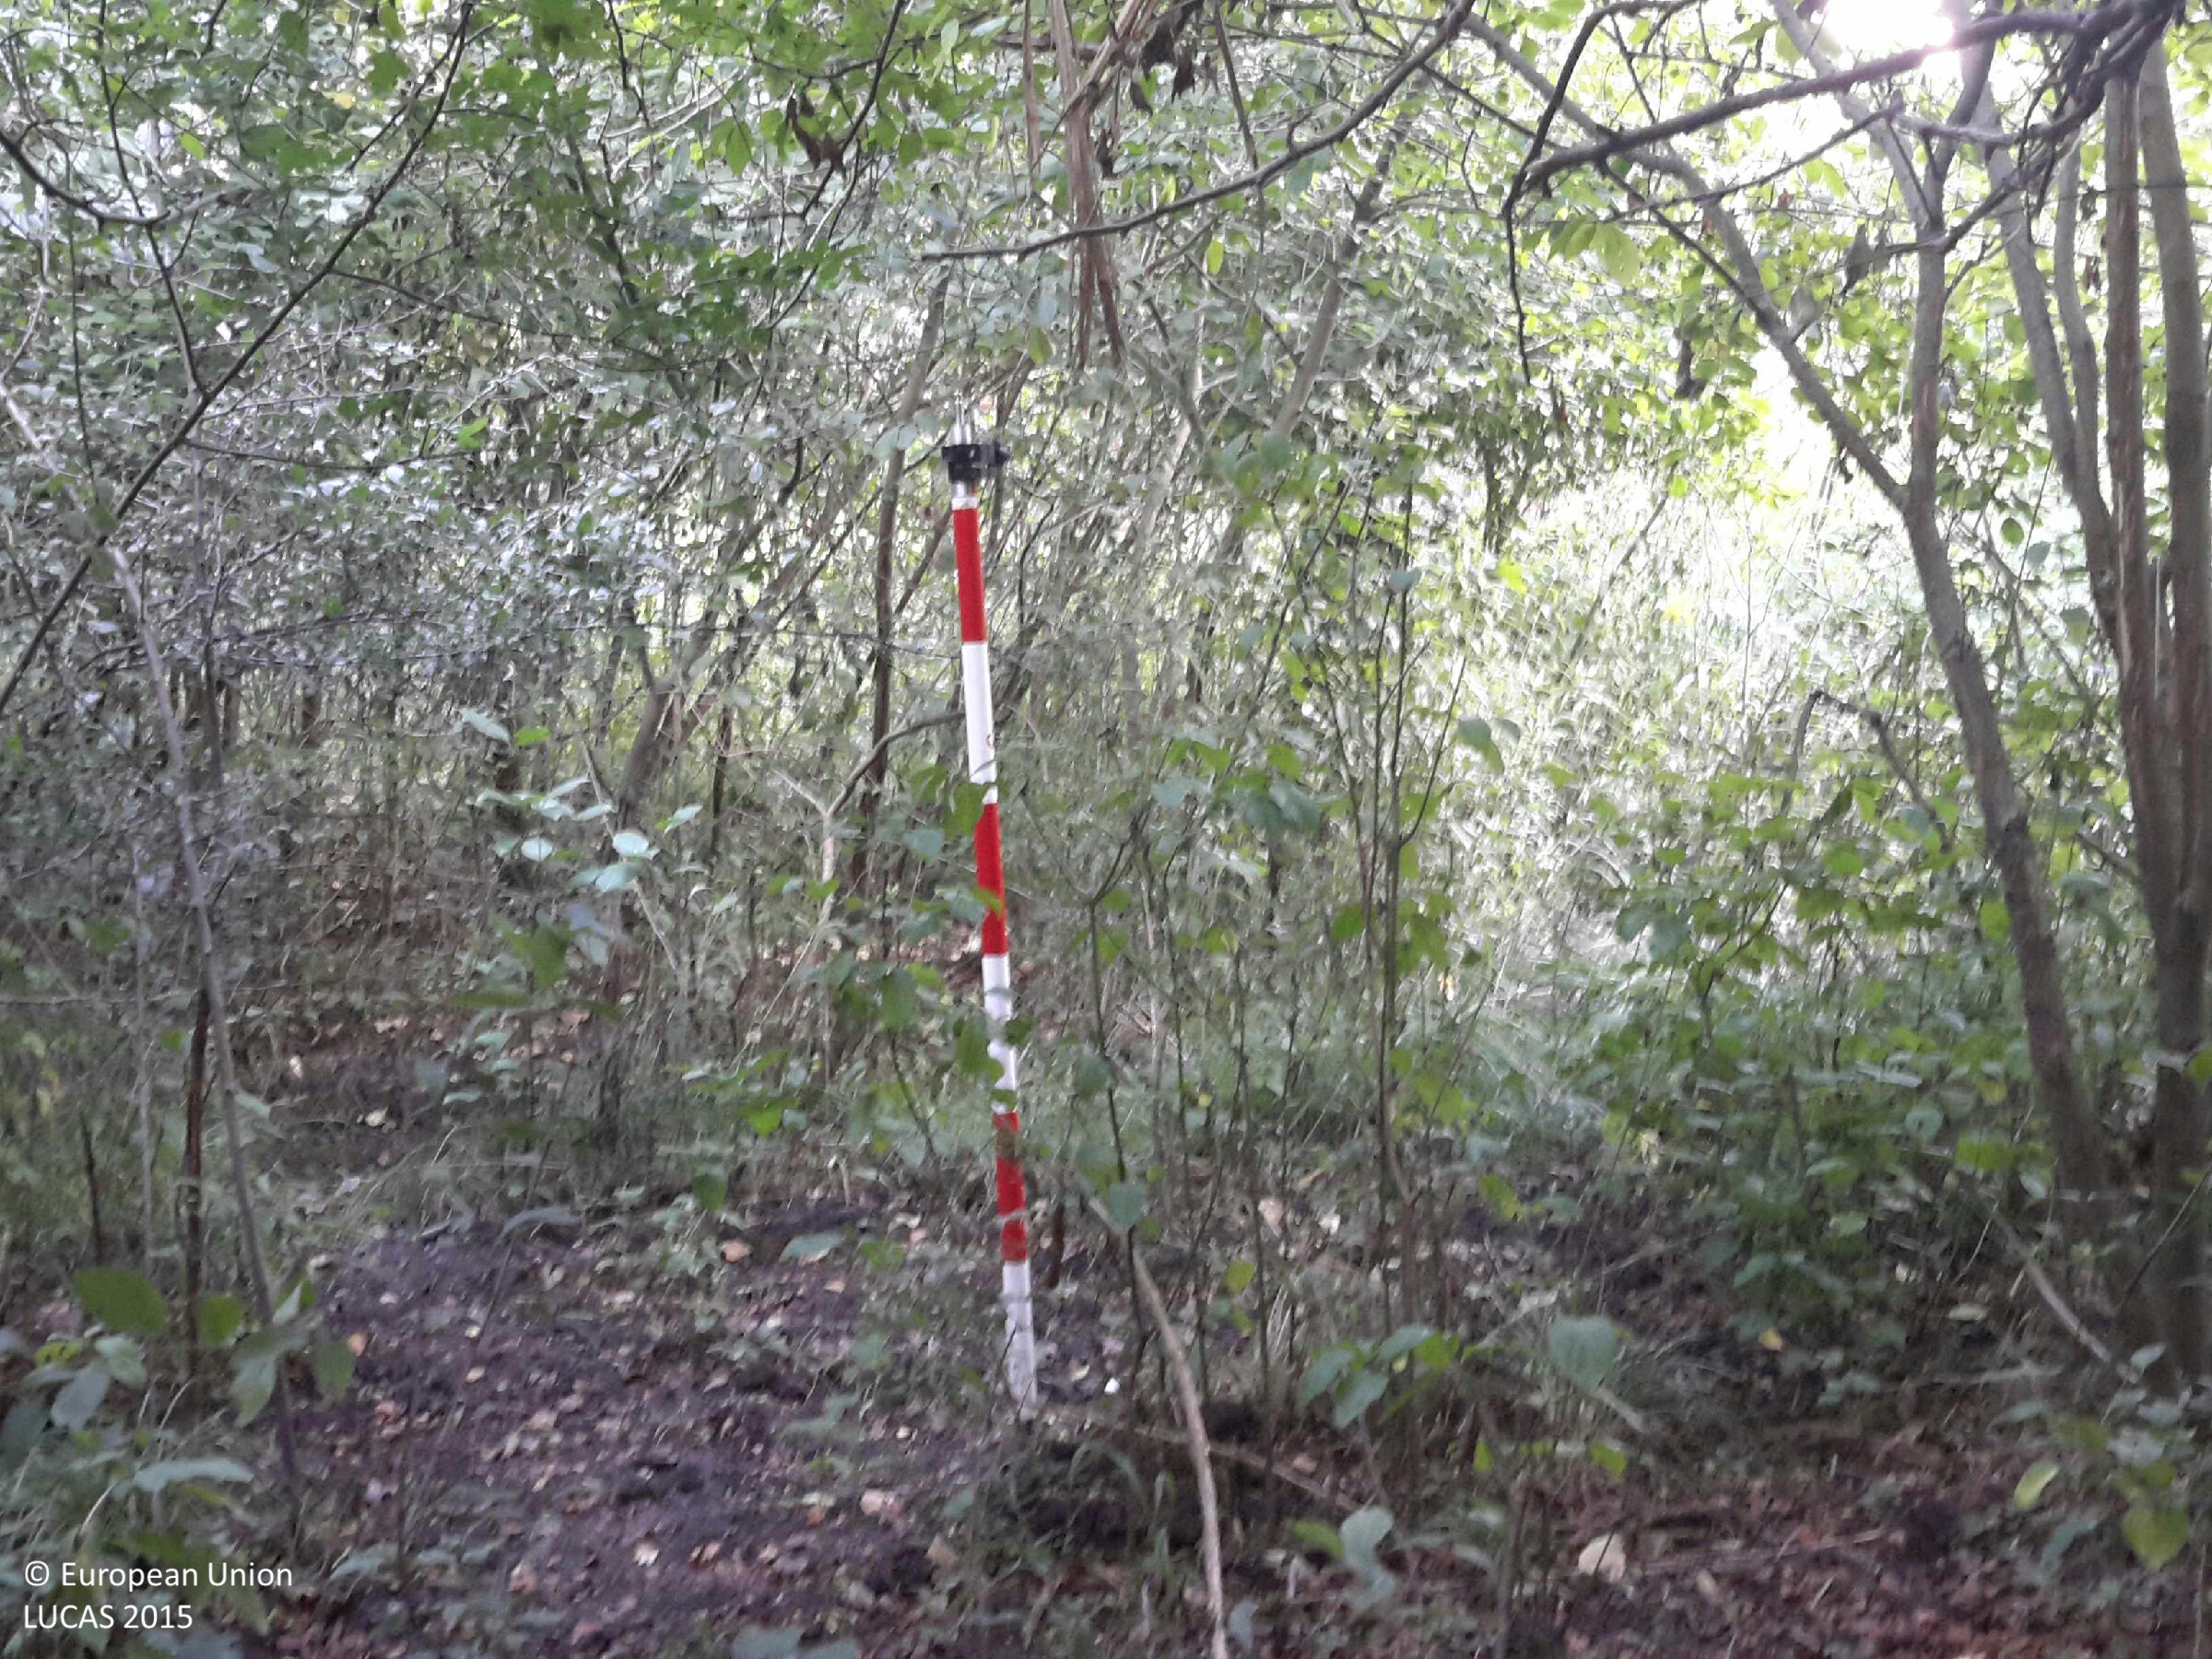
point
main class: Woodland
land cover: Broadleaved woodland
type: thermophilous deciduous forest
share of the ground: > 75 %
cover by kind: broadleaved forest trees 60 %, shrubs 30 %, herbaceous plants 10 %
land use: Forestry
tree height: > 5 m
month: August
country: HU
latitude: 47.2702
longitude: 17.3956
